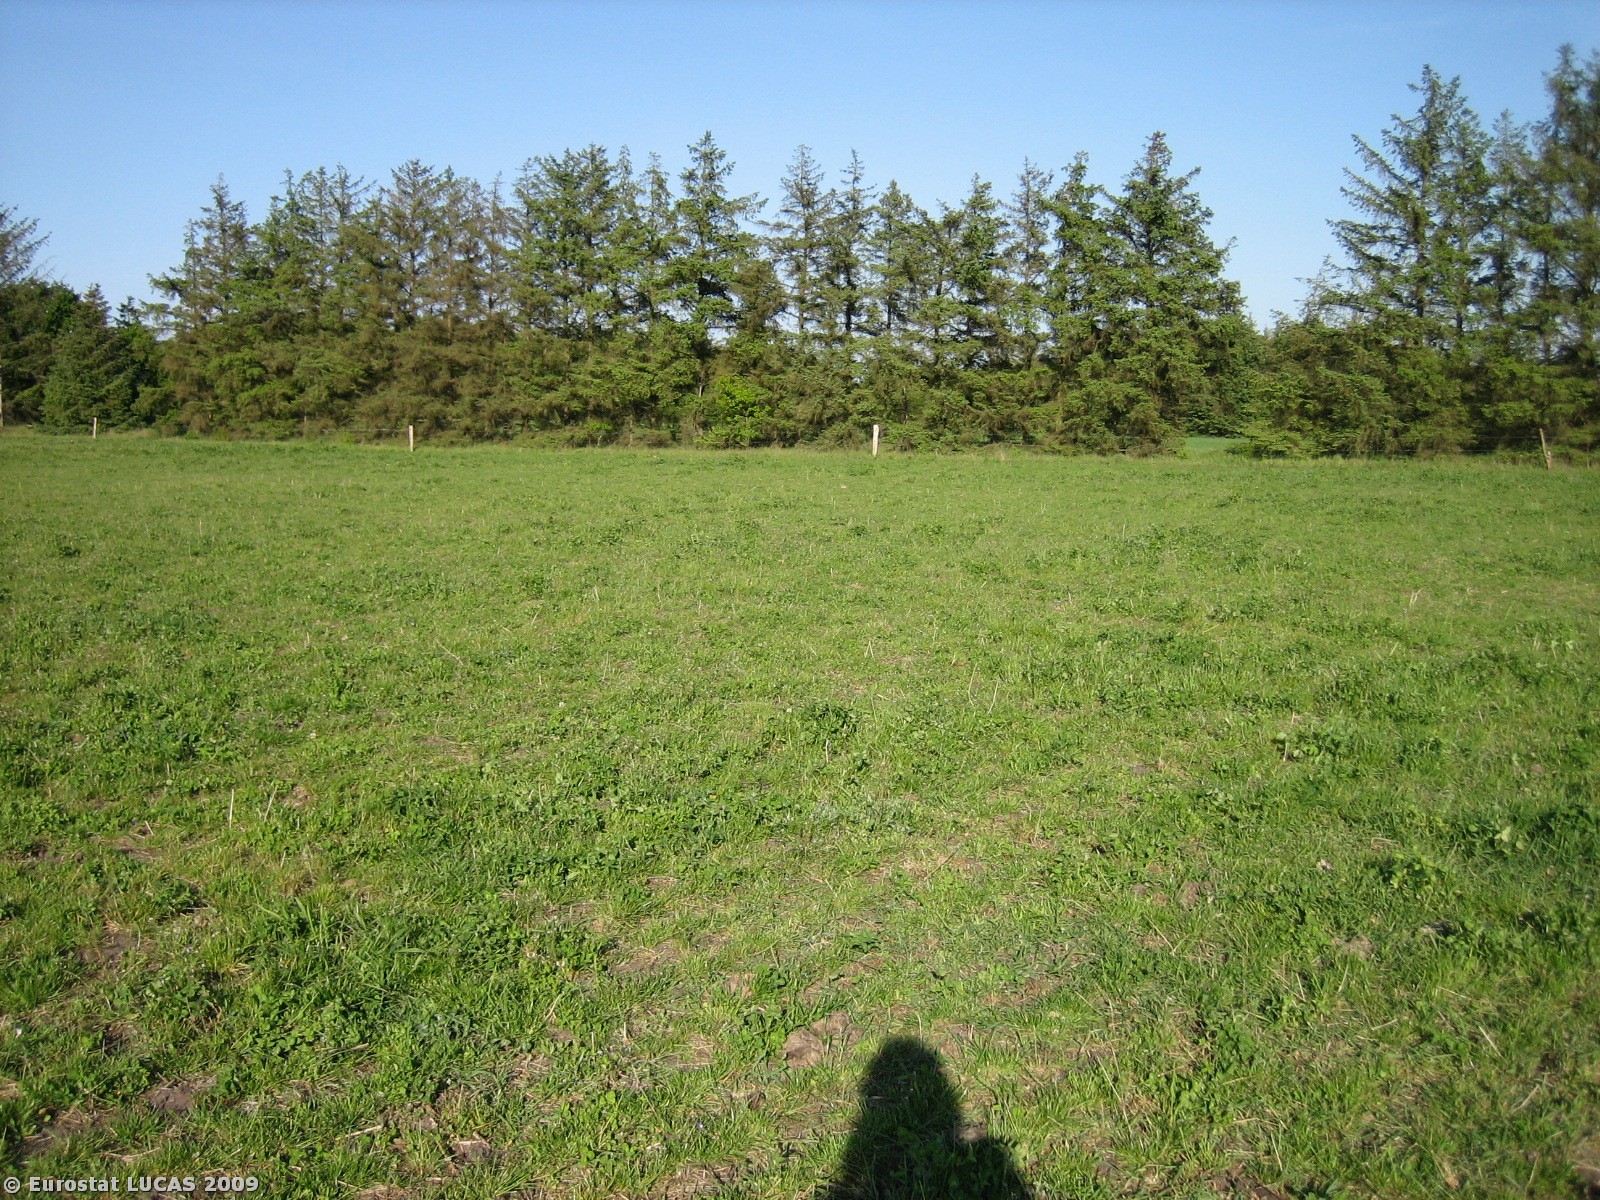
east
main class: Grassland
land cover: Grassland without tree/shrub cover
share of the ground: > 75 %
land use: Agriculture (excluding fallow land and kitchen gardens)
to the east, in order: Grassland without tree/shrub cover; Fences; Grass margins; Tracks; Coniferous woodland; Triticale; Grassland without tree/shrub cover
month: May
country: DK
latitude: 55.8422
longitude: 8.9950
